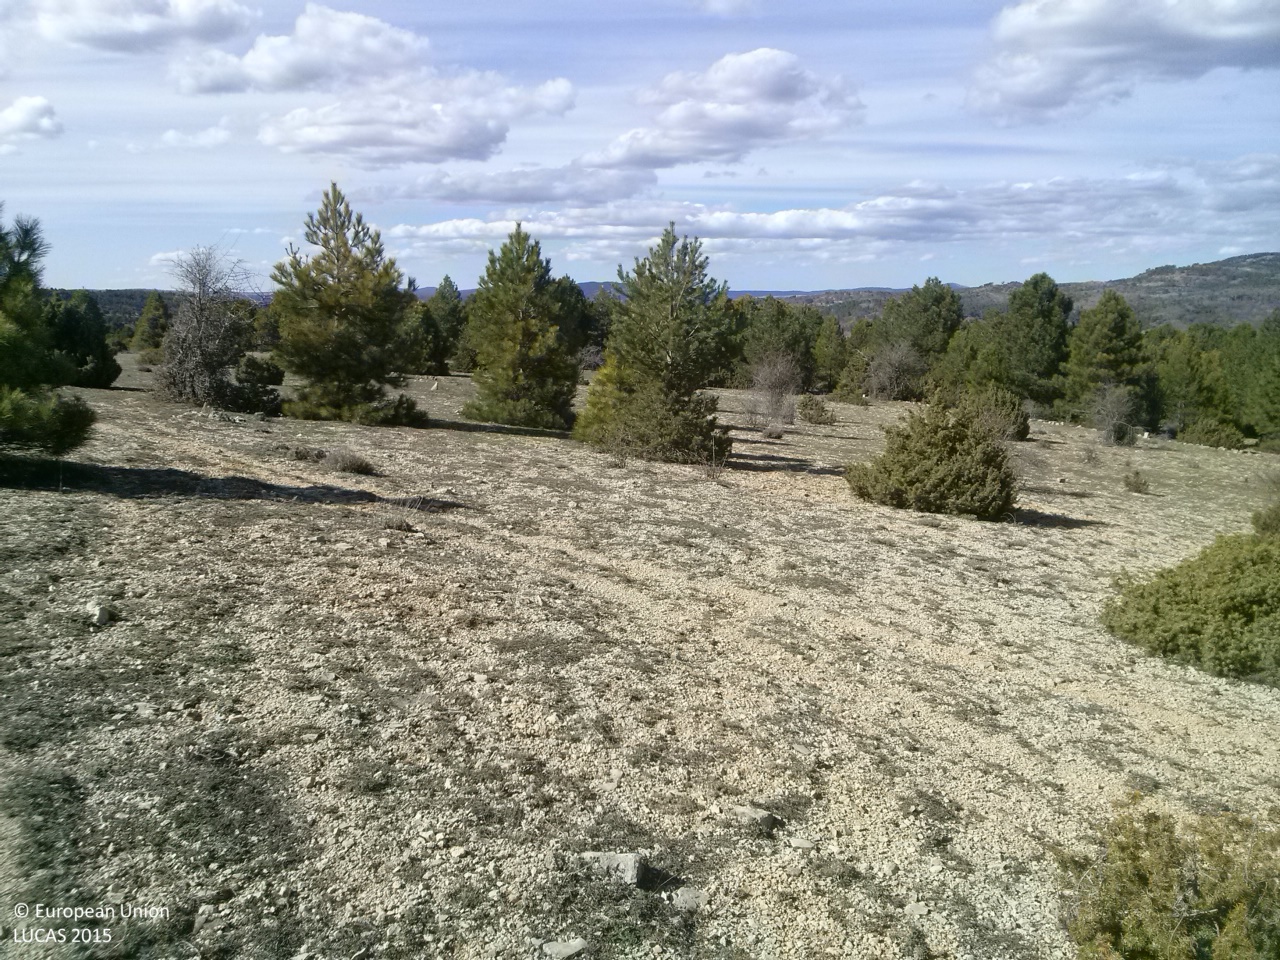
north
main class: Grassland
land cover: Grassland without tree/shrub cover
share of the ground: 25 - 50 %
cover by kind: unconsolidated bare surface 55 %, herbaceous plants 40 %, shrubs 5 %
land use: Agriculture (excluding fallow land and kitchen gardens)
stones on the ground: 25 - 50 %
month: April
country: ES
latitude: 40.1689
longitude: -1.8388
